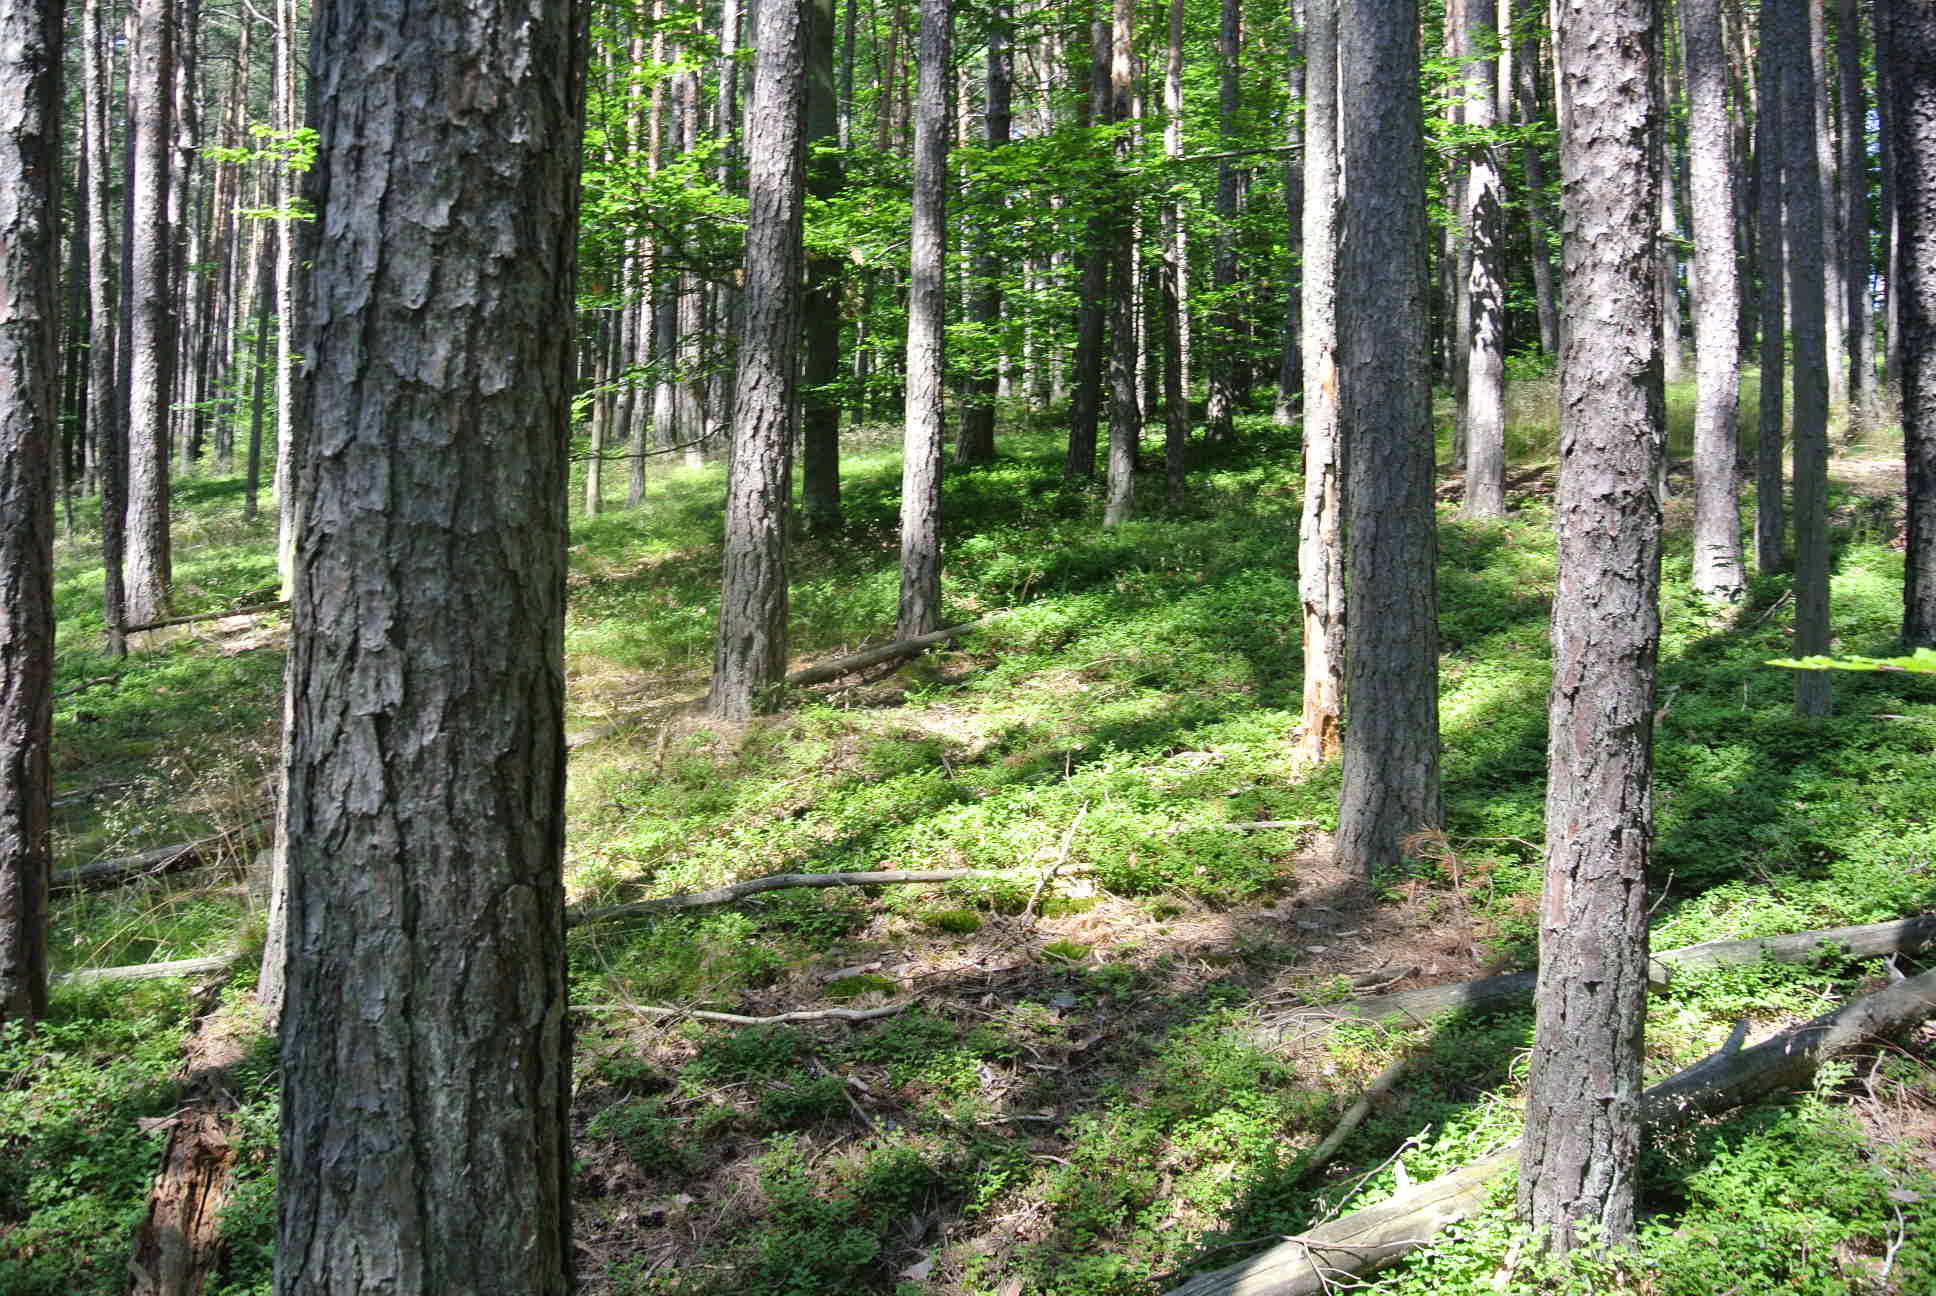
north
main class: Woodland
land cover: Pine dominated coniferous woodland
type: alpine coniferous forest
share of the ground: > 75 %
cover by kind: coniferous forest trees 85 %, broadleaved forest trees 10 %, lichens and mosses 5 %
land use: Forestry
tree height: > 5 m
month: July
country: AT
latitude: 47.6045
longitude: 16.0815
